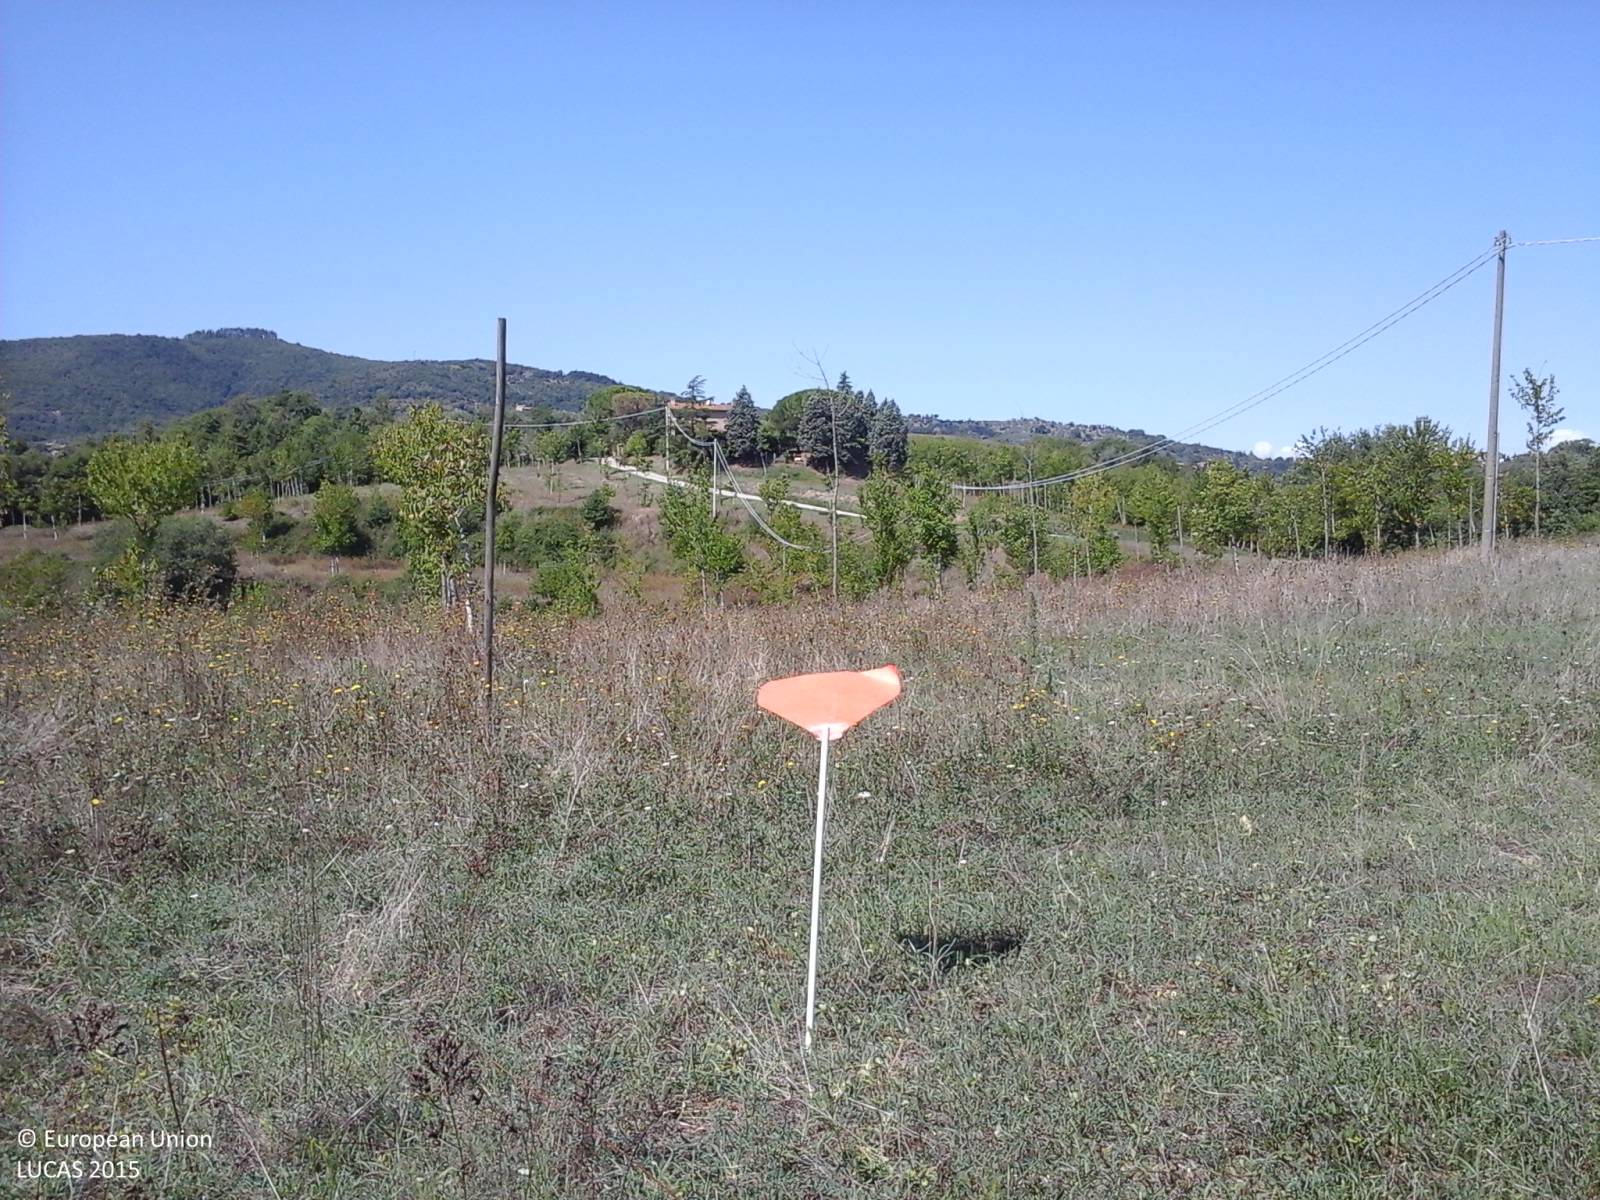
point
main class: Cropland
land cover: Nuts trees
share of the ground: 10 - 25 %
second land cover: Grassland without tree/shrub cover
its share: > 75 %
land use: Agriculture (excluding fallow land and kitchen gardens)
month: September
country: IT
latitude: 43.0113
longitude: 12.1162
